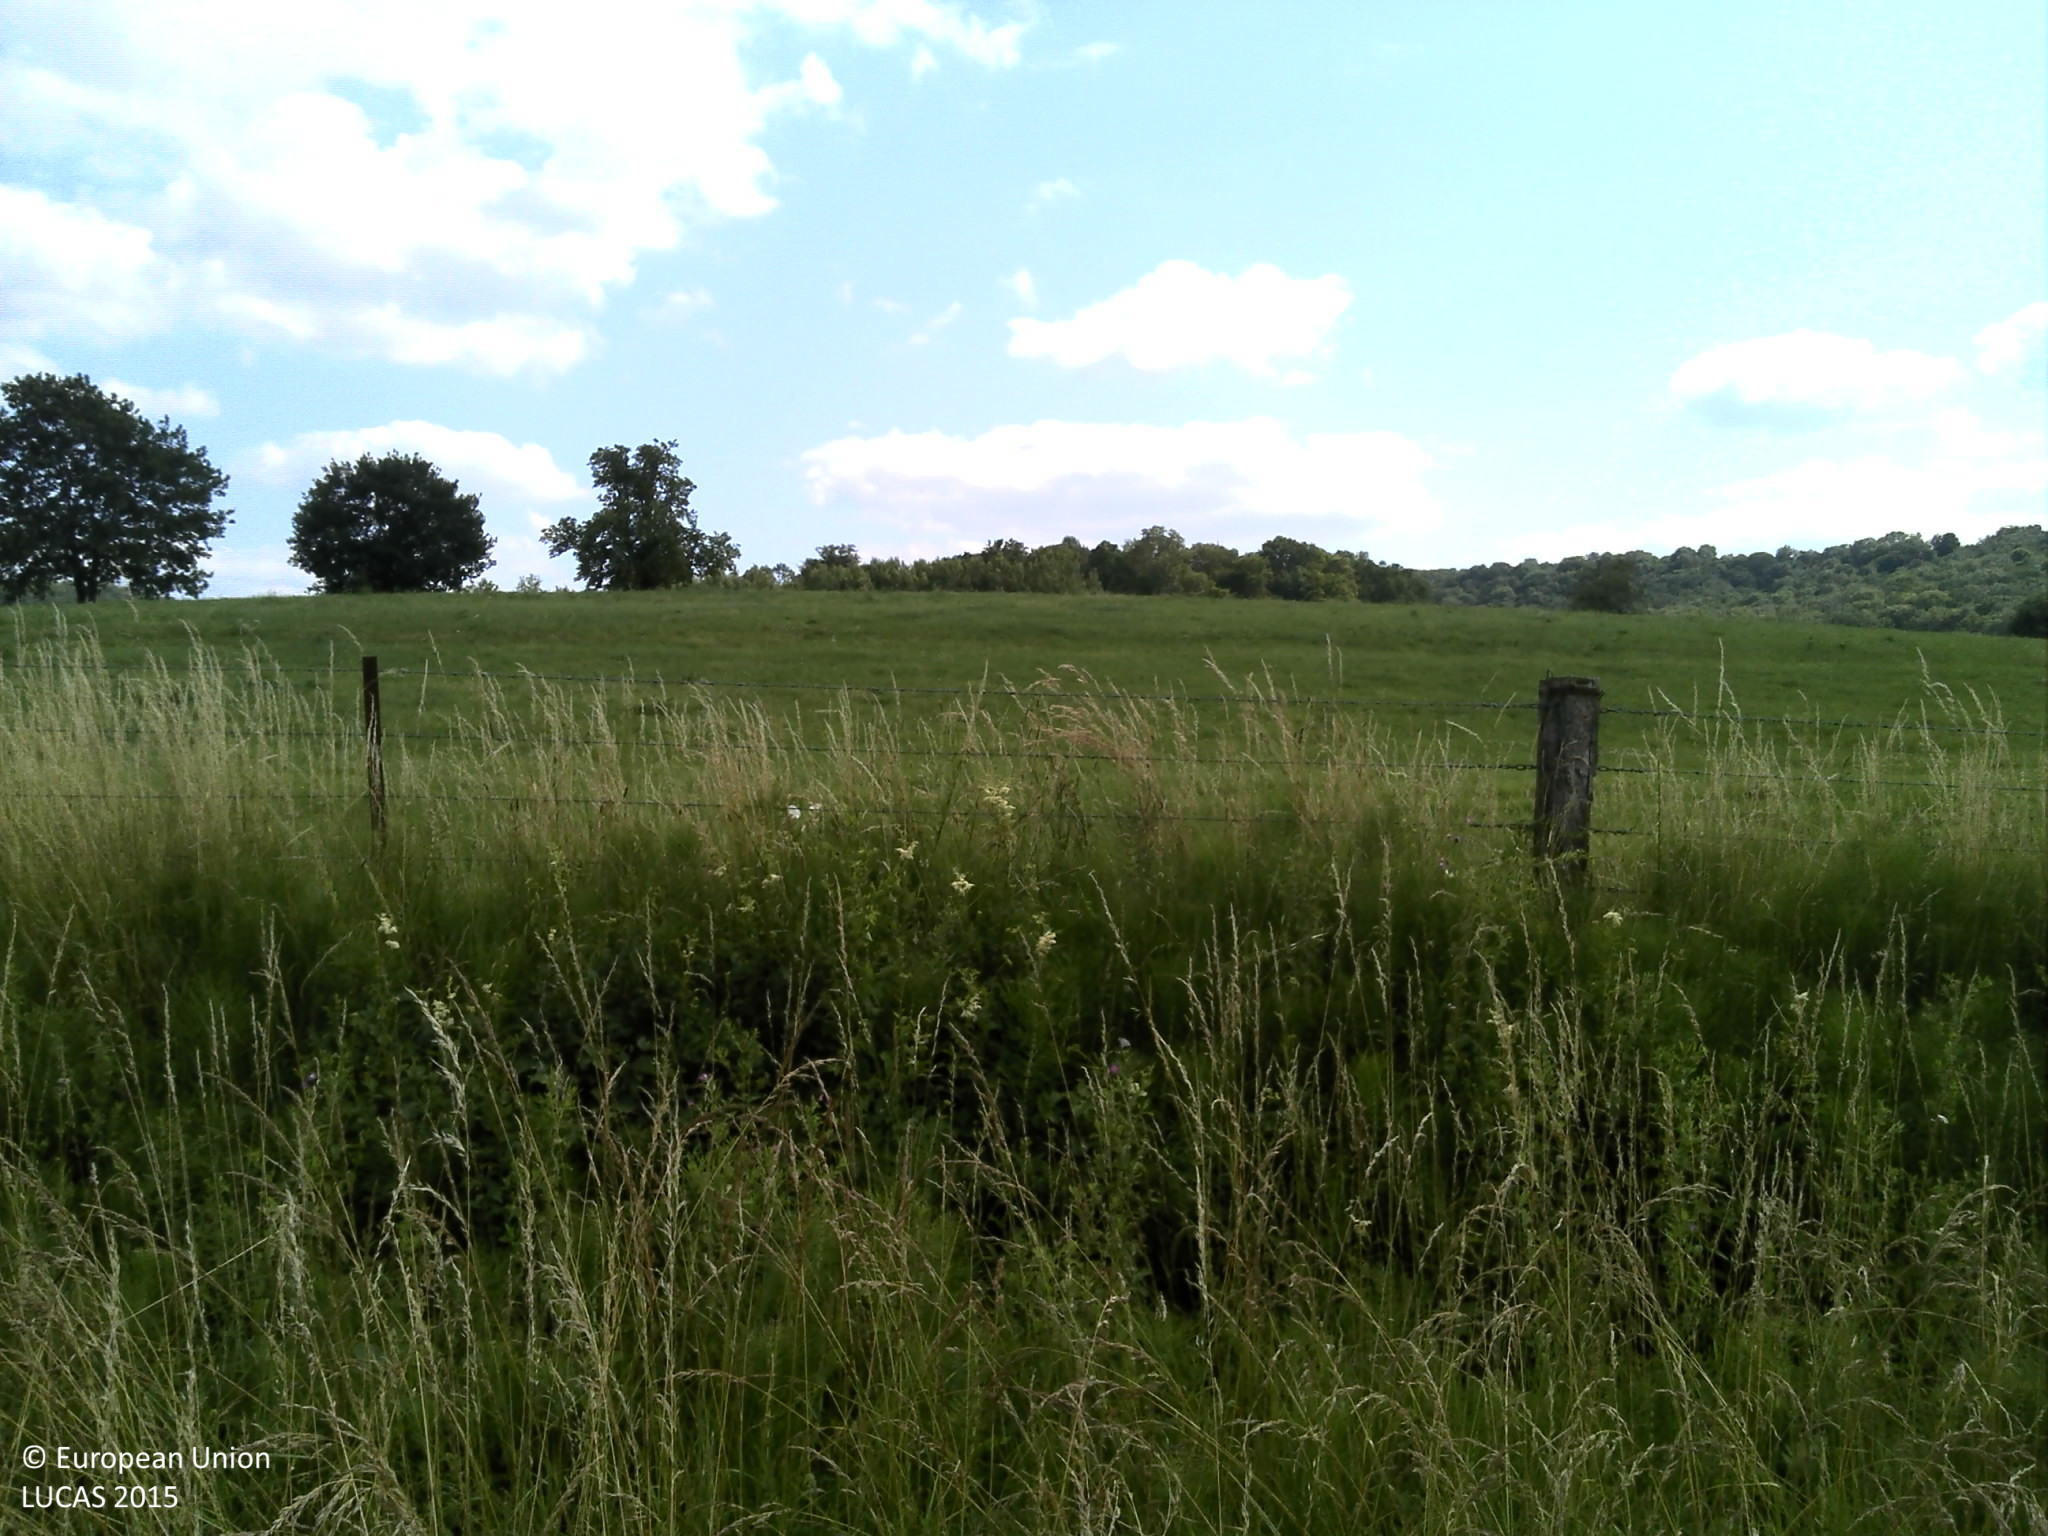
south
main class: Artificial land
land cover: Non built-up linear features
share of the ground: > 75 %
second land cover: Spontaneously vegetated surfaces
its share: 25 - 50 %
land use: Road transport
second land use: Agriculture (excluding fallow land and kitchen gardens)
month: July
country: FR
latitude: 49.6422
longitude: 4.6095
